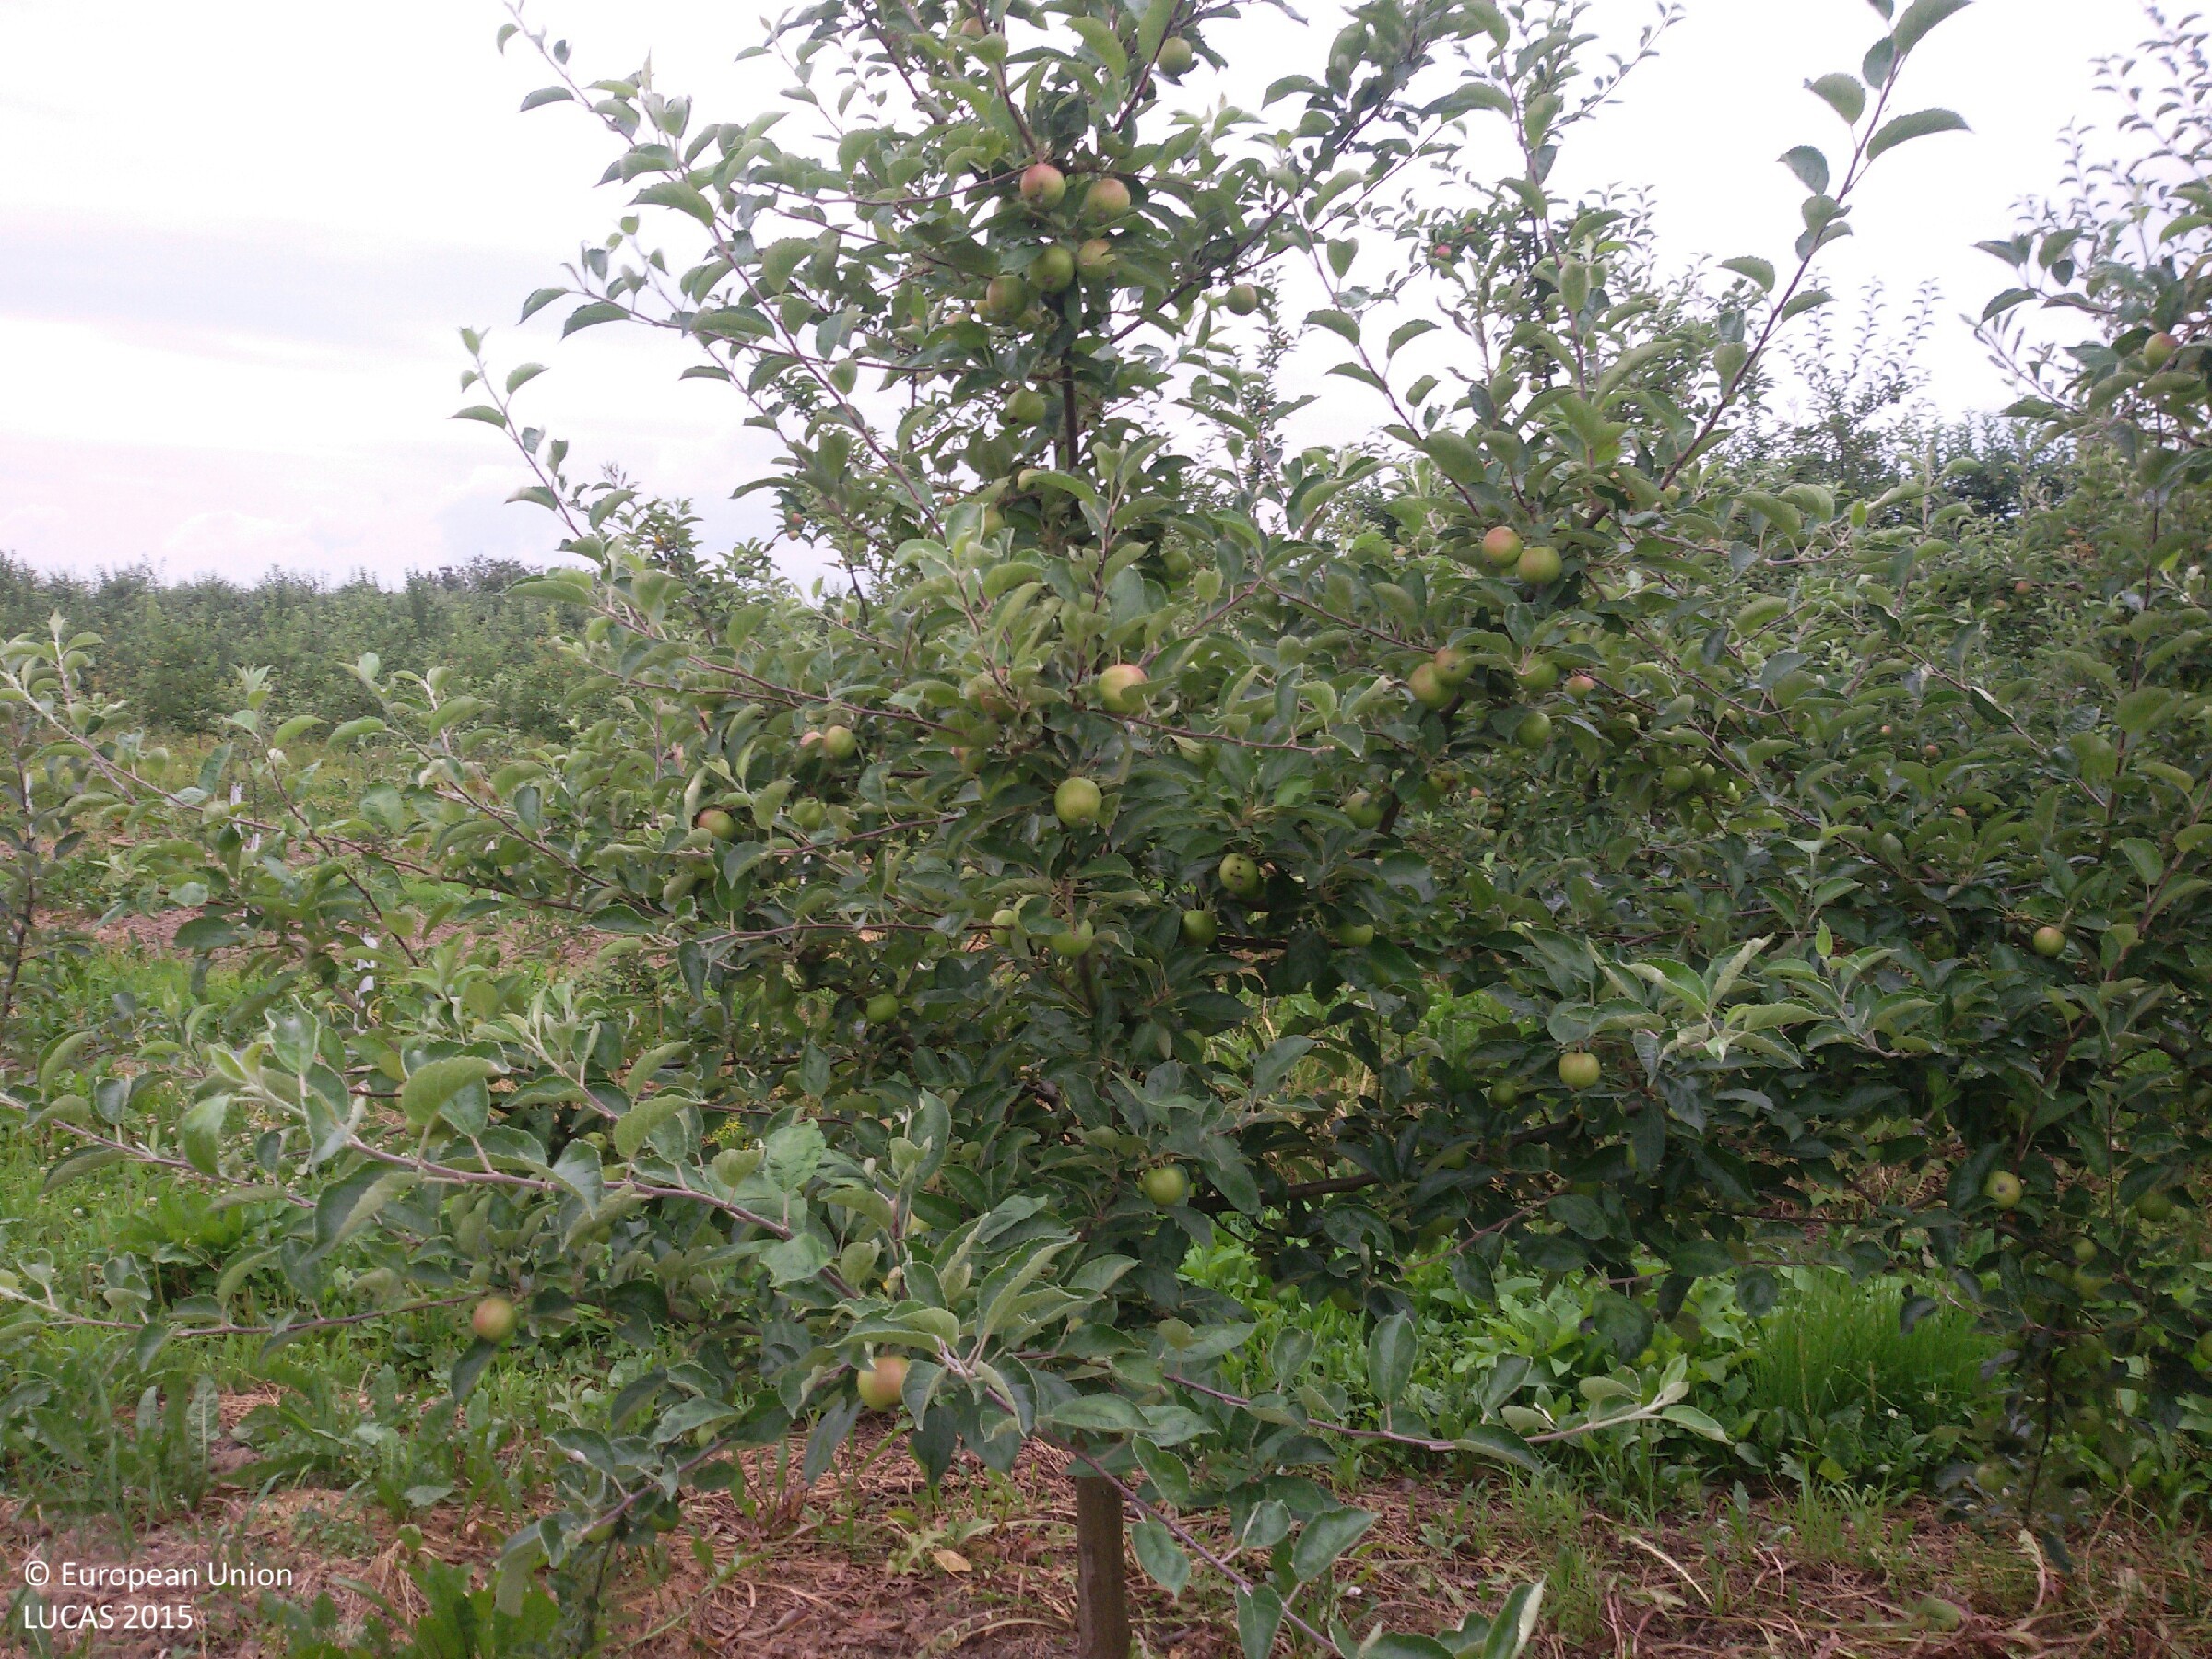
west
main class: Cropland
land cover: Apple fruit
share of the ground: 50 - 75 %
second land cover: Grassland without tree/shrub cover
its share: 50 - 75 %
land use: Agriculture (excluding fallow land and kitchen gardens)
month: July
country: PL
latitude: 51.1865
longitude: 21.8017
